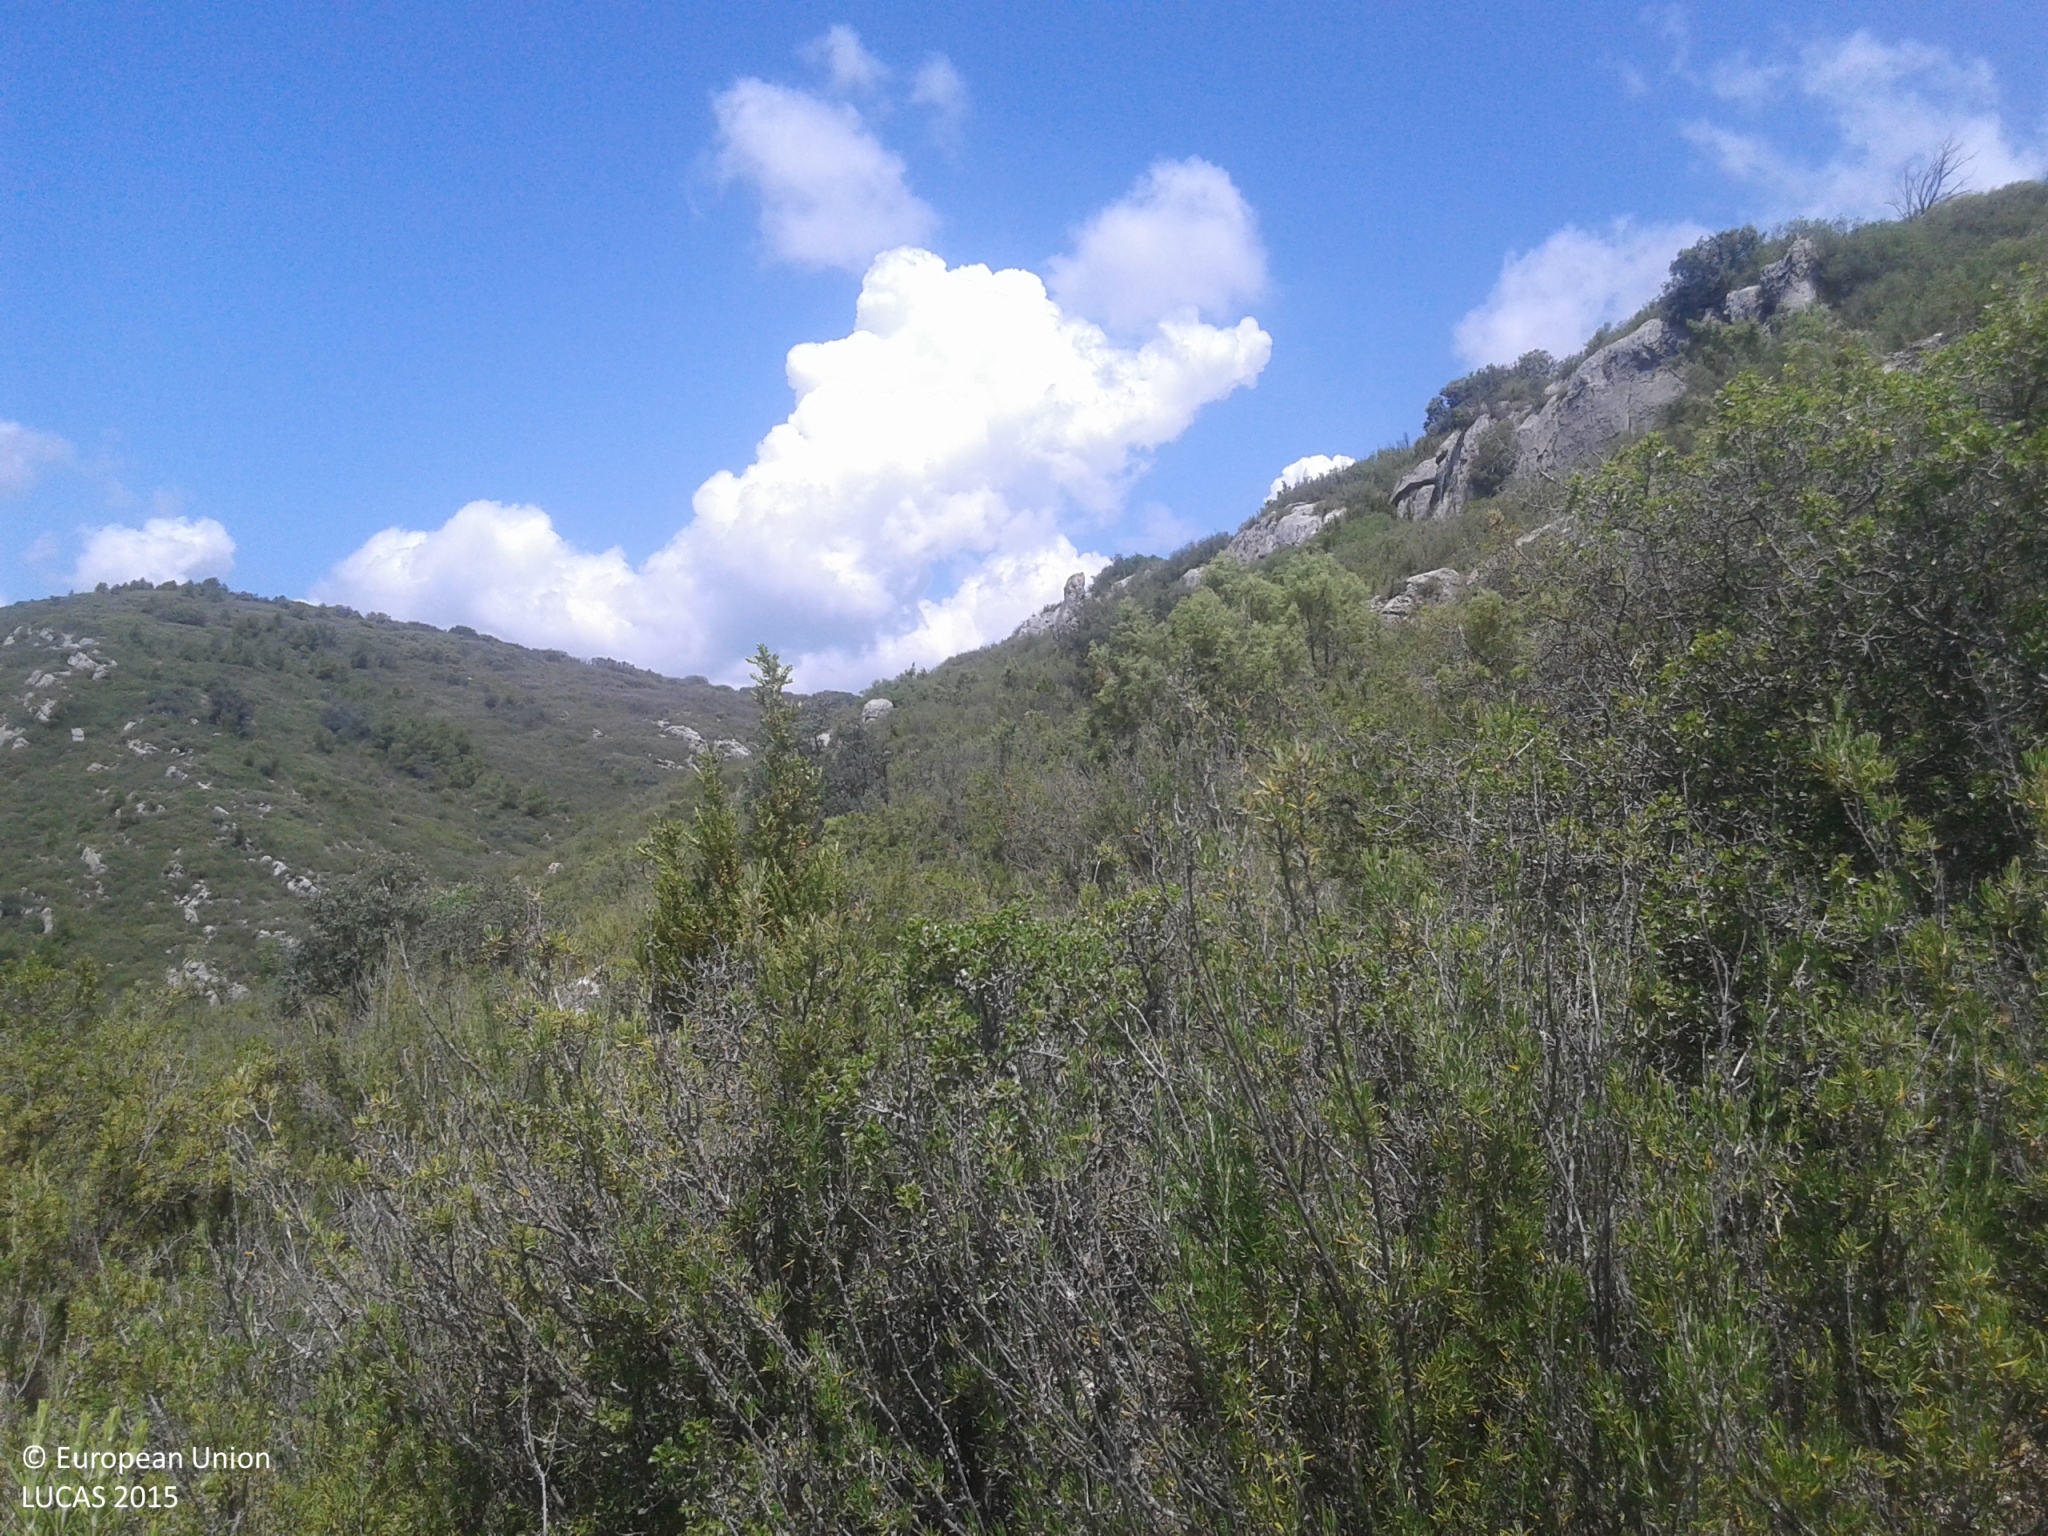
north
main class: Shrubland
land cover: Shrubland with sparse tree cover
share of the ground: > 75 %
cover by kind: shrubs 90 %, broadleaved forest trees 5 %, consolidated bare surface 5 %
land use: Semi-natural and natural areas not in use
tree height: > 5 m
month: June
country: ES
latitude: 41.8931
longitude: 0.6448
